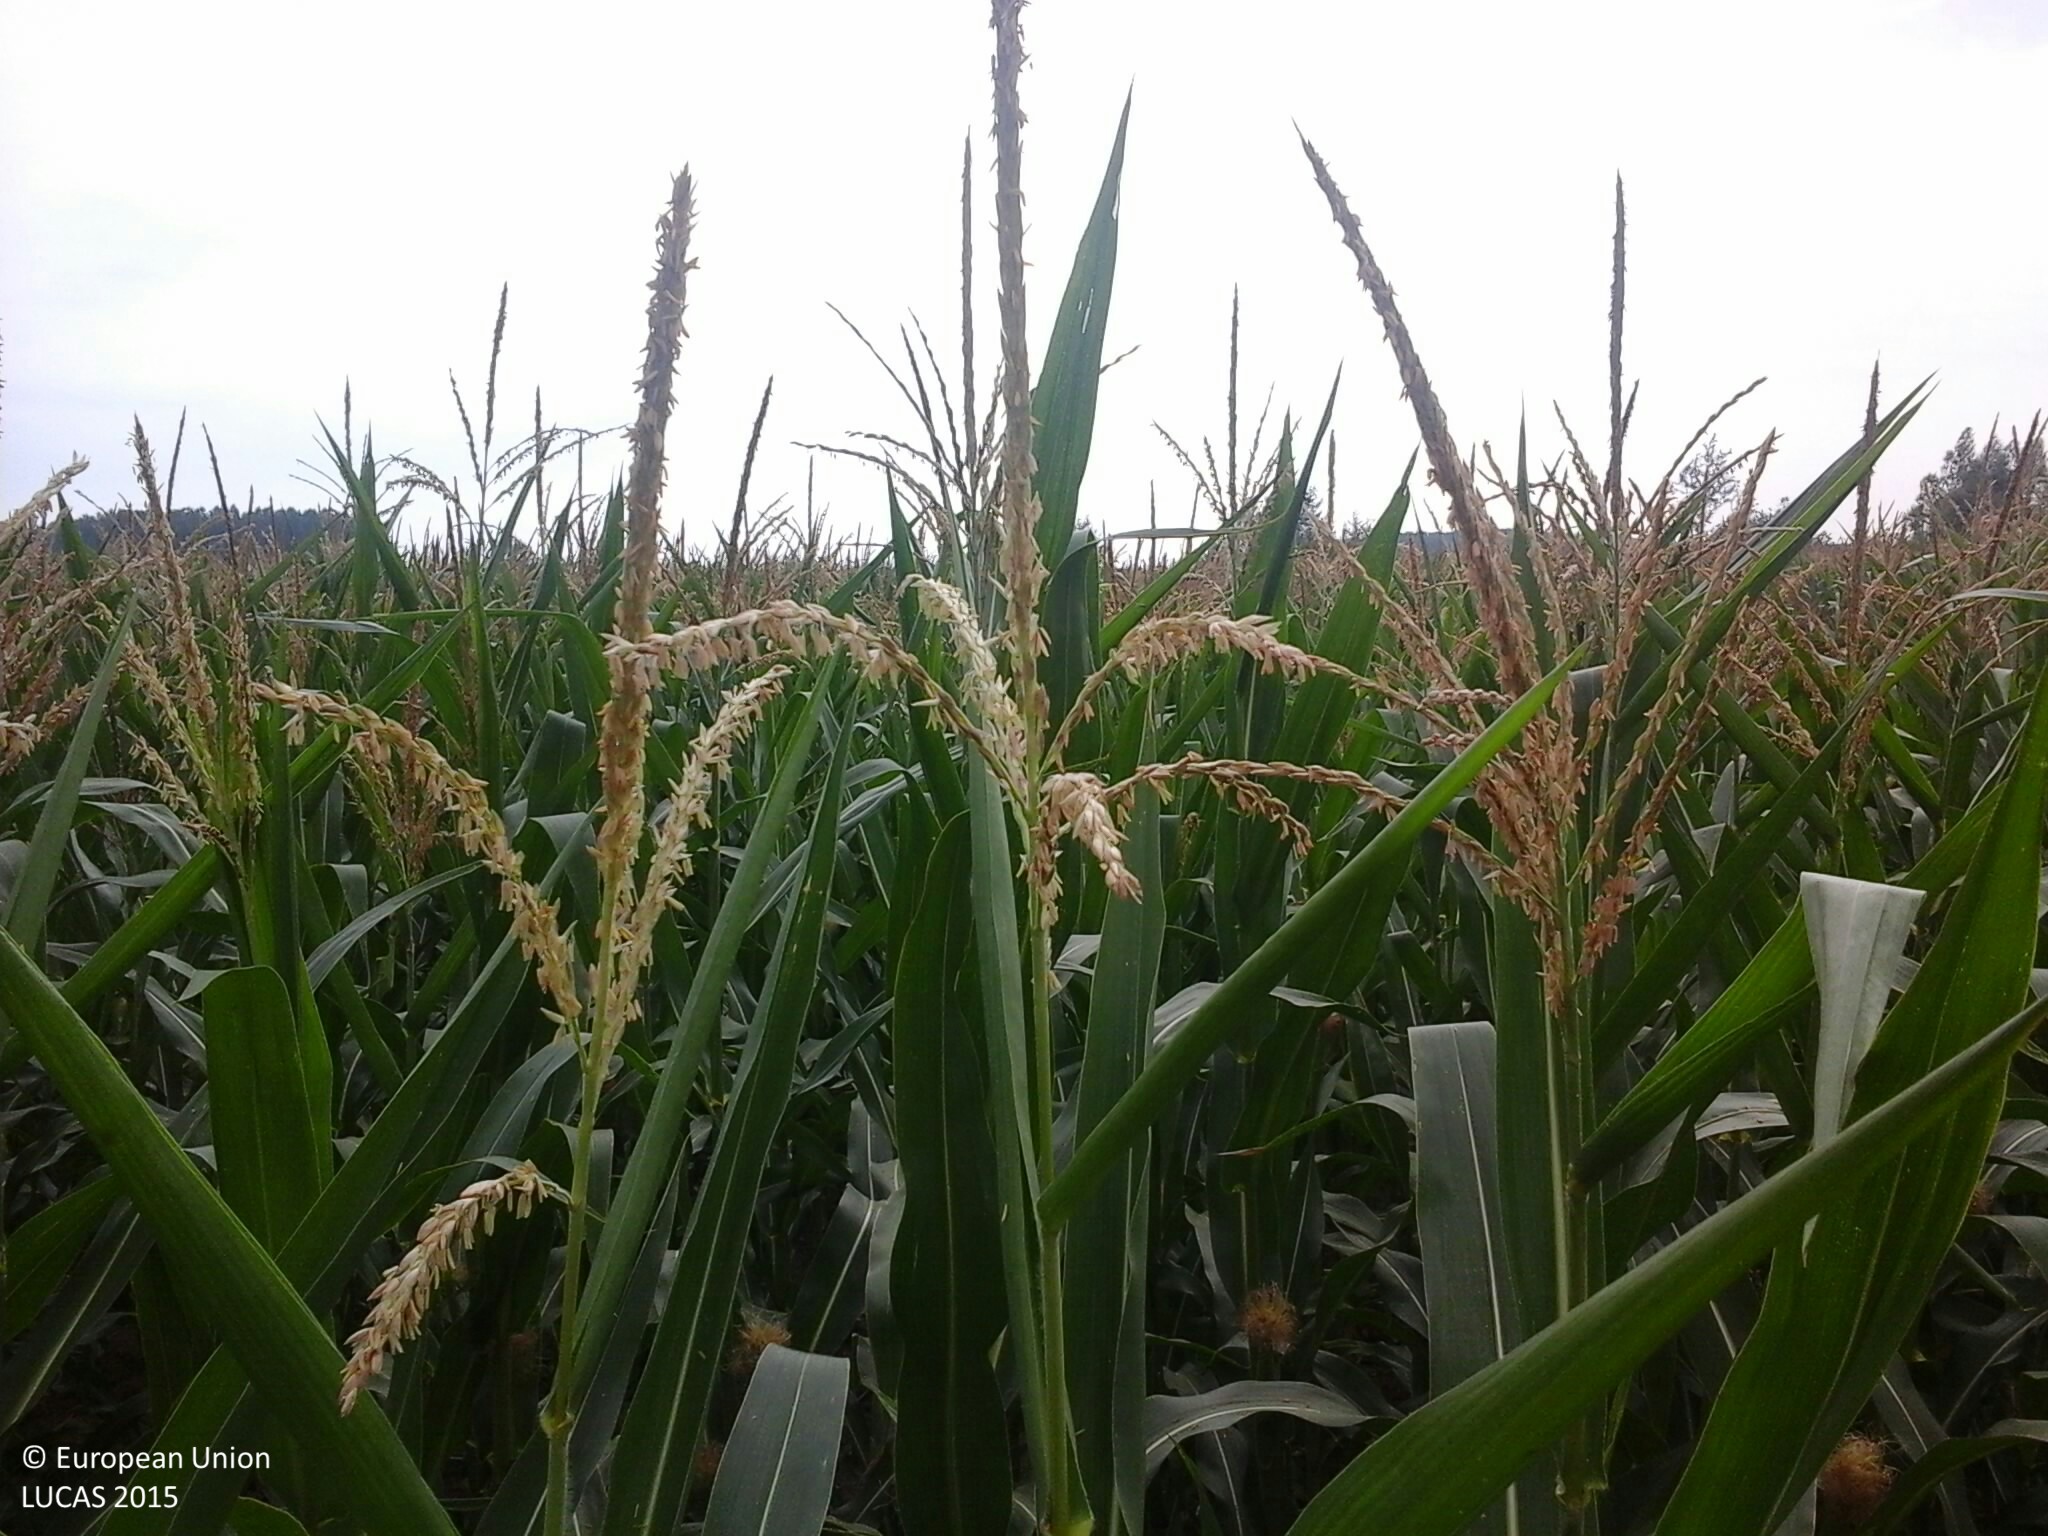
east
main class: Cropland
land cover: Maize
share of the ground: > 75 %
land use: Agriculture (excluding fallow land and kitchen gardens)
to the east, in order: Tracks; Maize; Shrubland with sparse tree cover; Maize
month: July
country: HU
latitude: 47.6867
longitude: 22.2170
